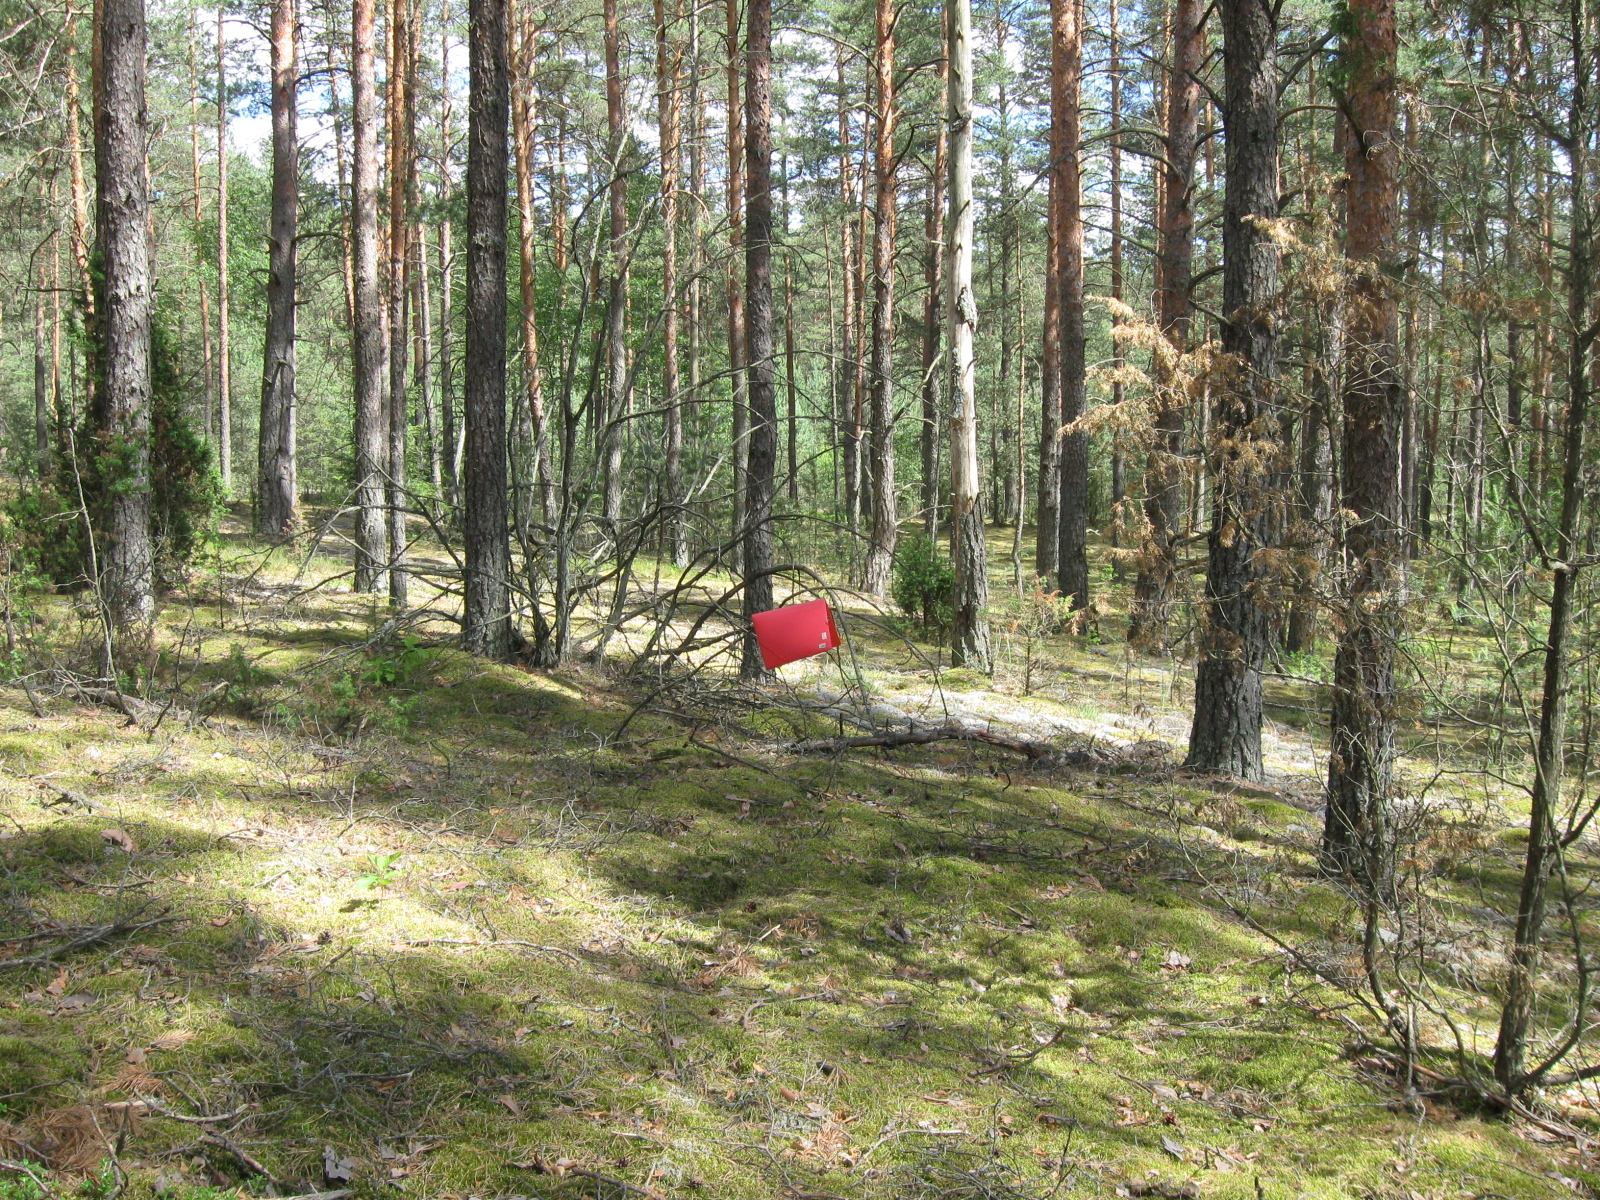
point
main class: Woodland
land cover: Pine dominated coniferous woodland
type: hemiboreal forest and nemoral coniferous forest and mixed broadleaved-coniferous forest
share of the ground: > 75 %
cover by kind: coniferous forest trees 95 %, lichens and mosses 5 %
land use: Forestry
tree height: > 5 m
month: June
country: LT
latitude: 54.0964
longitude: 24.4925
